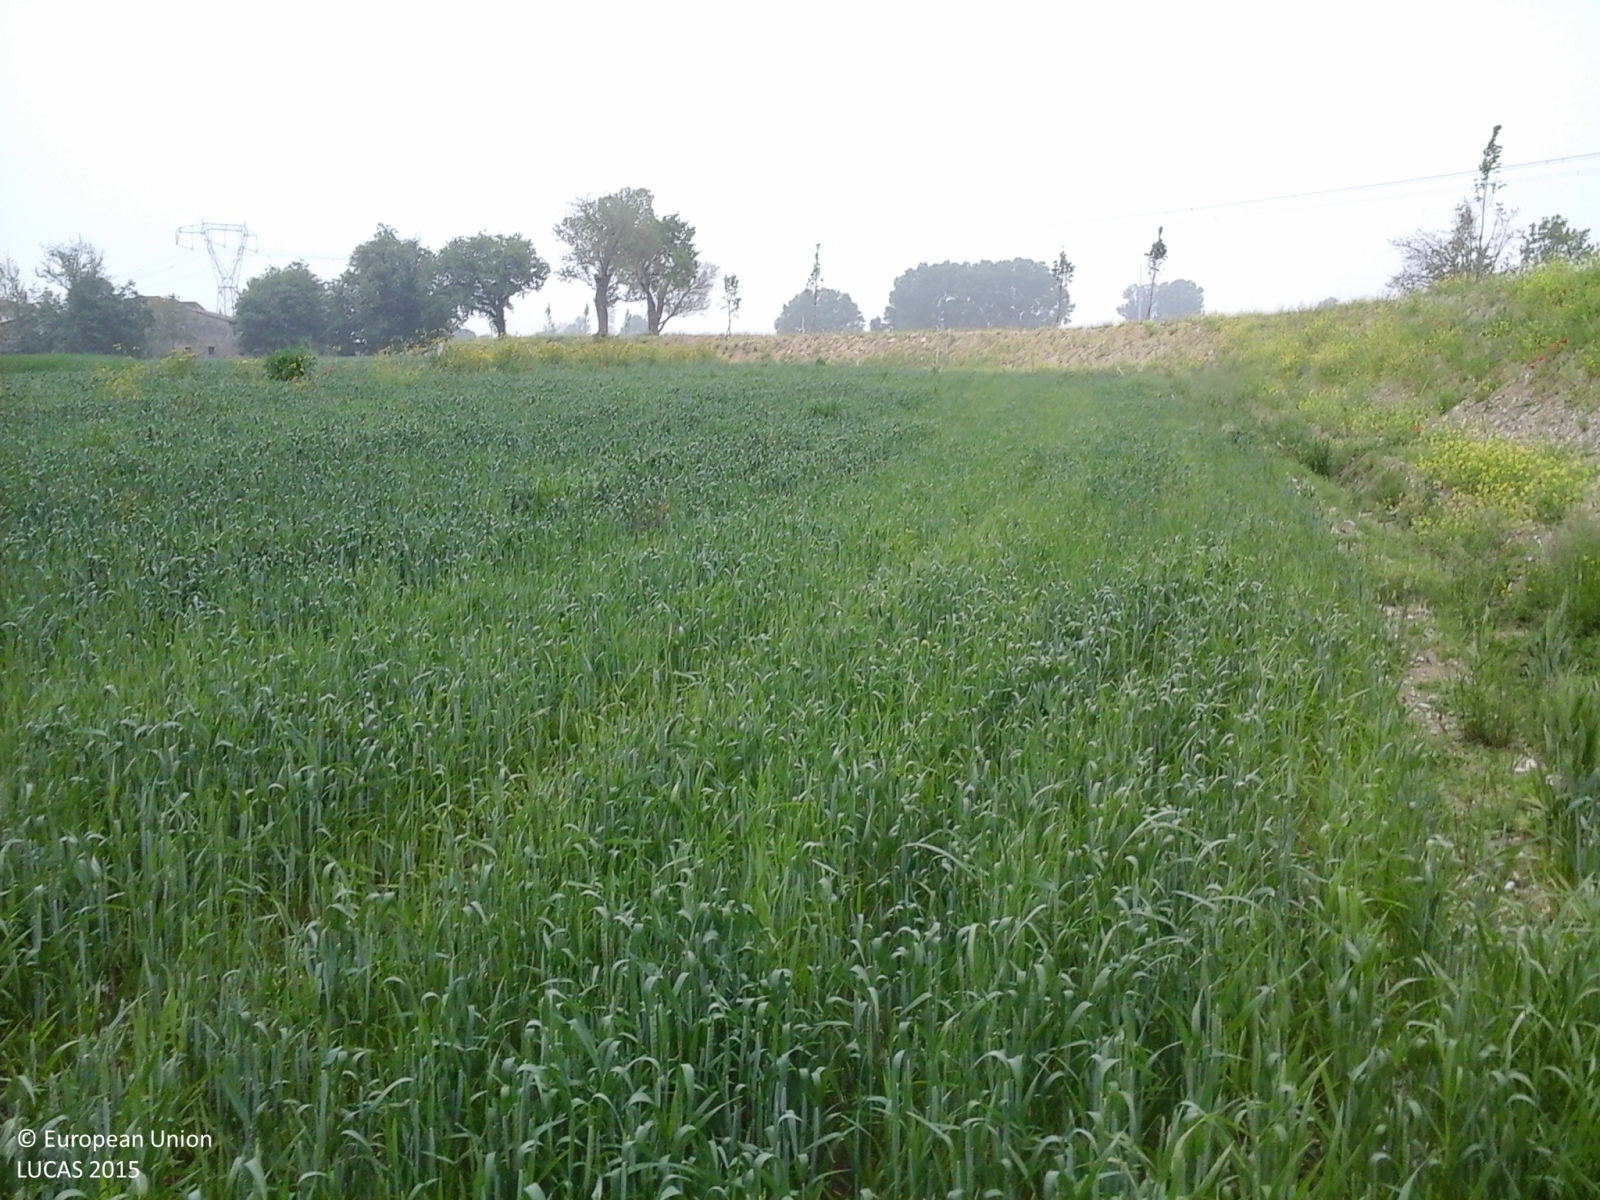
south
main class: Cropland
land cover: Common wheat
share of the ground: > 75 %
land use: Agriculture (excluding fallow land and kitchen gardens)
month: May
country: IT
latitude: 44.1050
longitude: 12.4555
